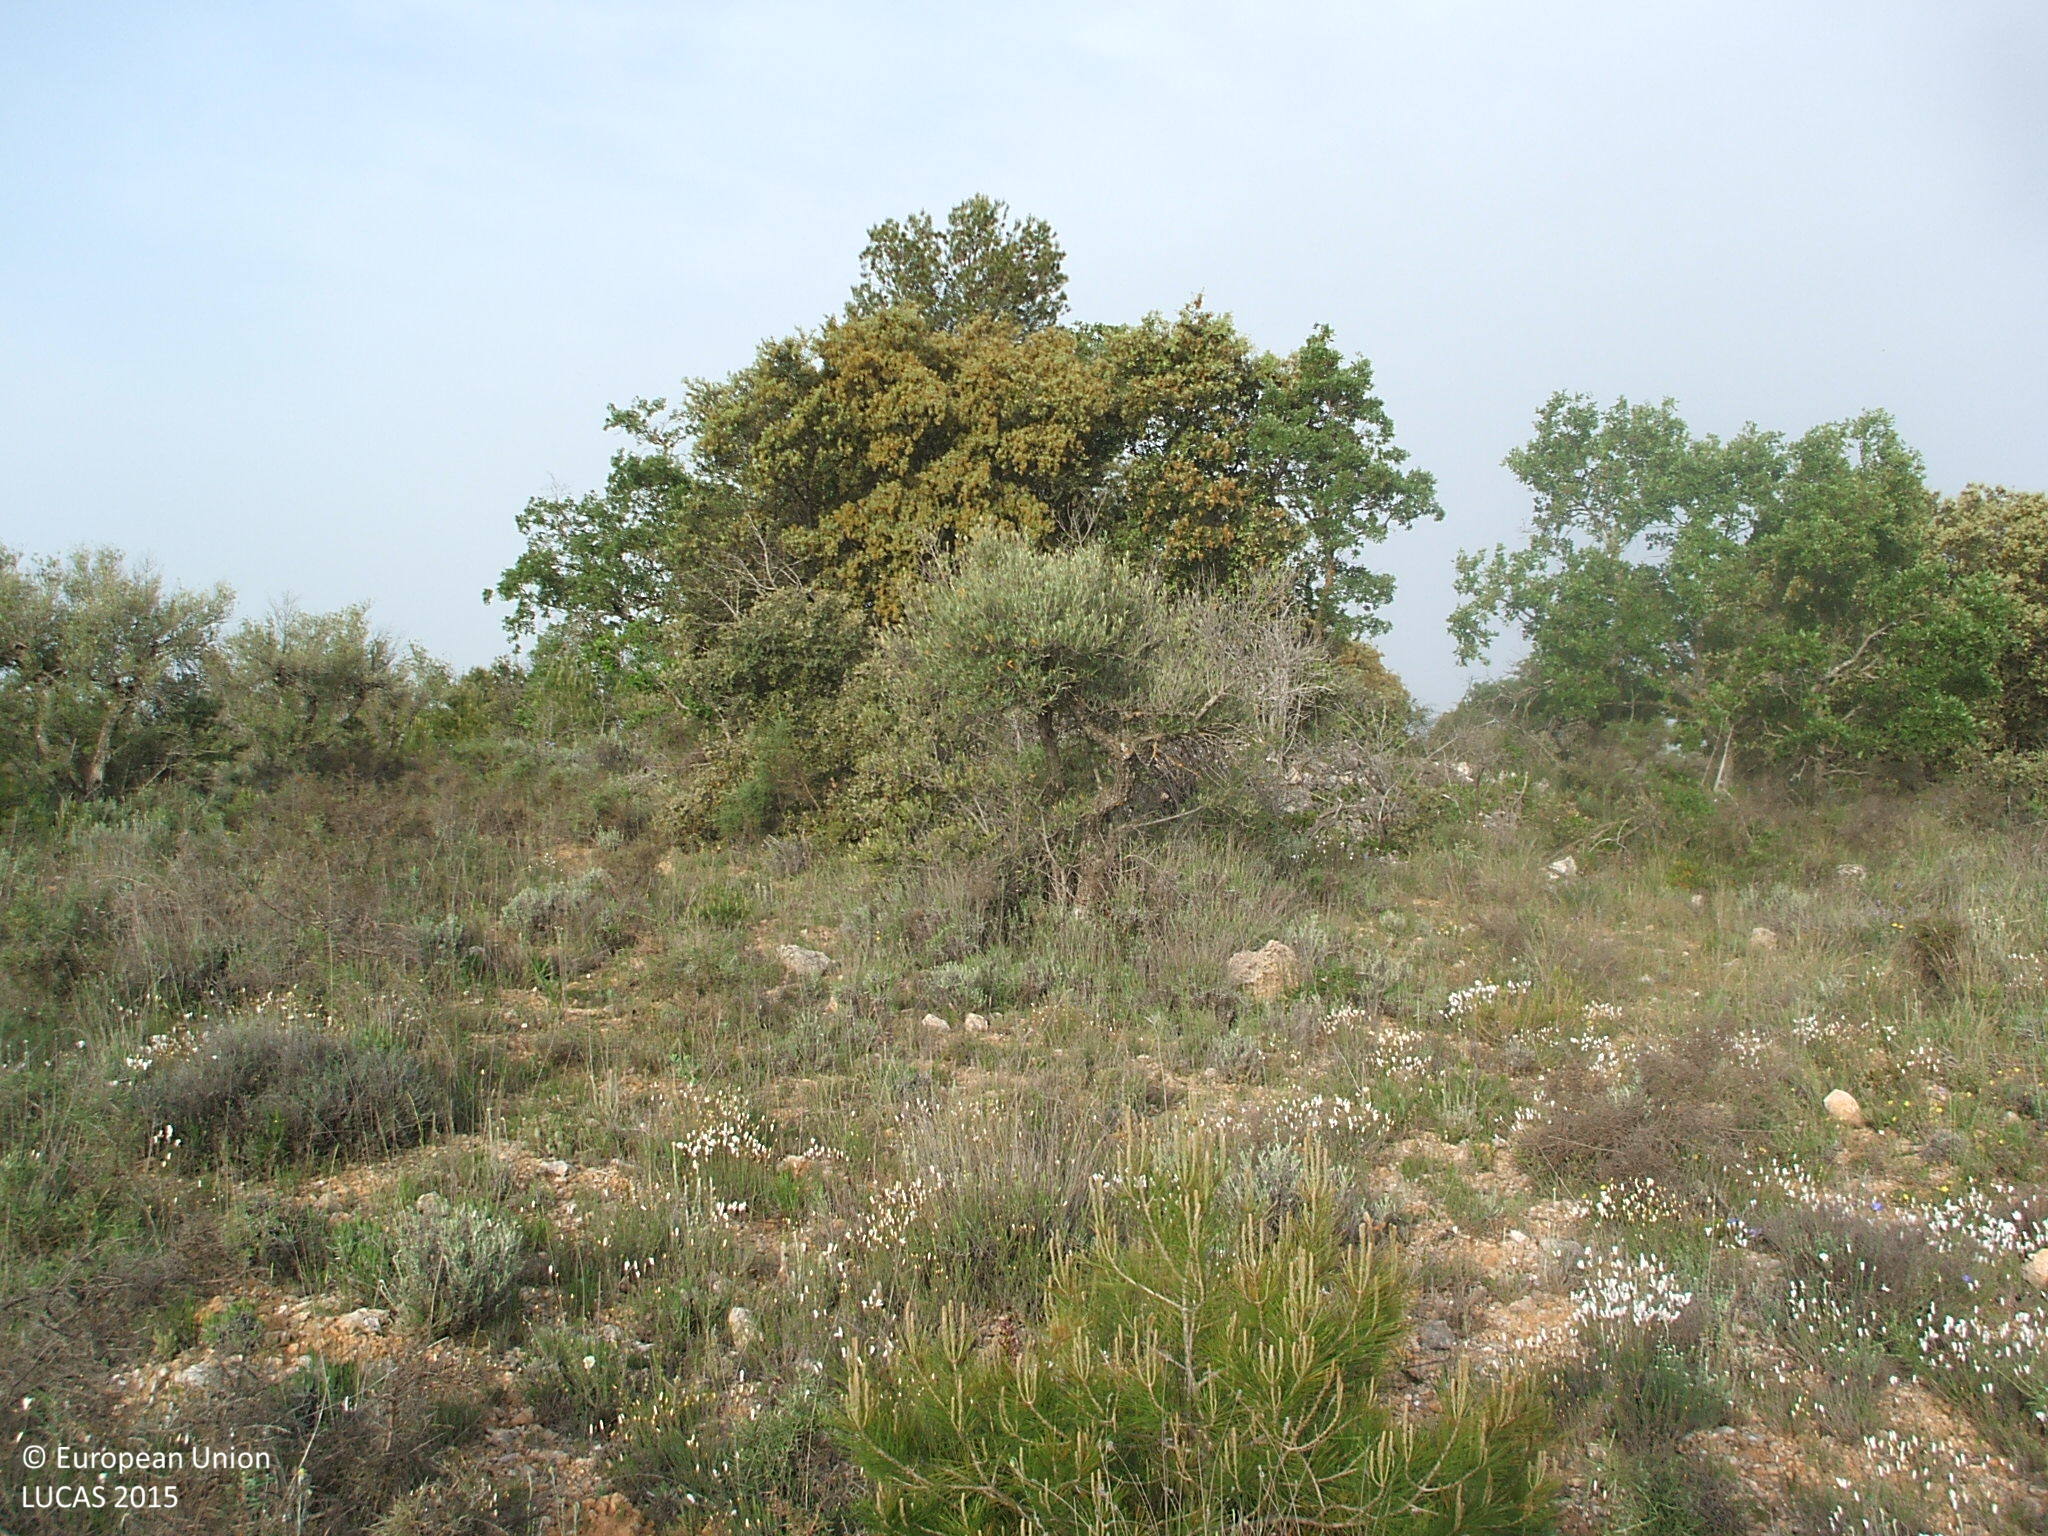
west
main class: Cropland
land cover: Olive groves
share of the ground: 10 - 25 %
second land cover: Grassland without tree/shrub cover
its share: > 75 %
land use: Agriculture (excluding fallow land and kitchen gardens)
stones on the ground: > 50 %
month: May
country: ES
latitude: 40.6335
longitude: -2.9298
